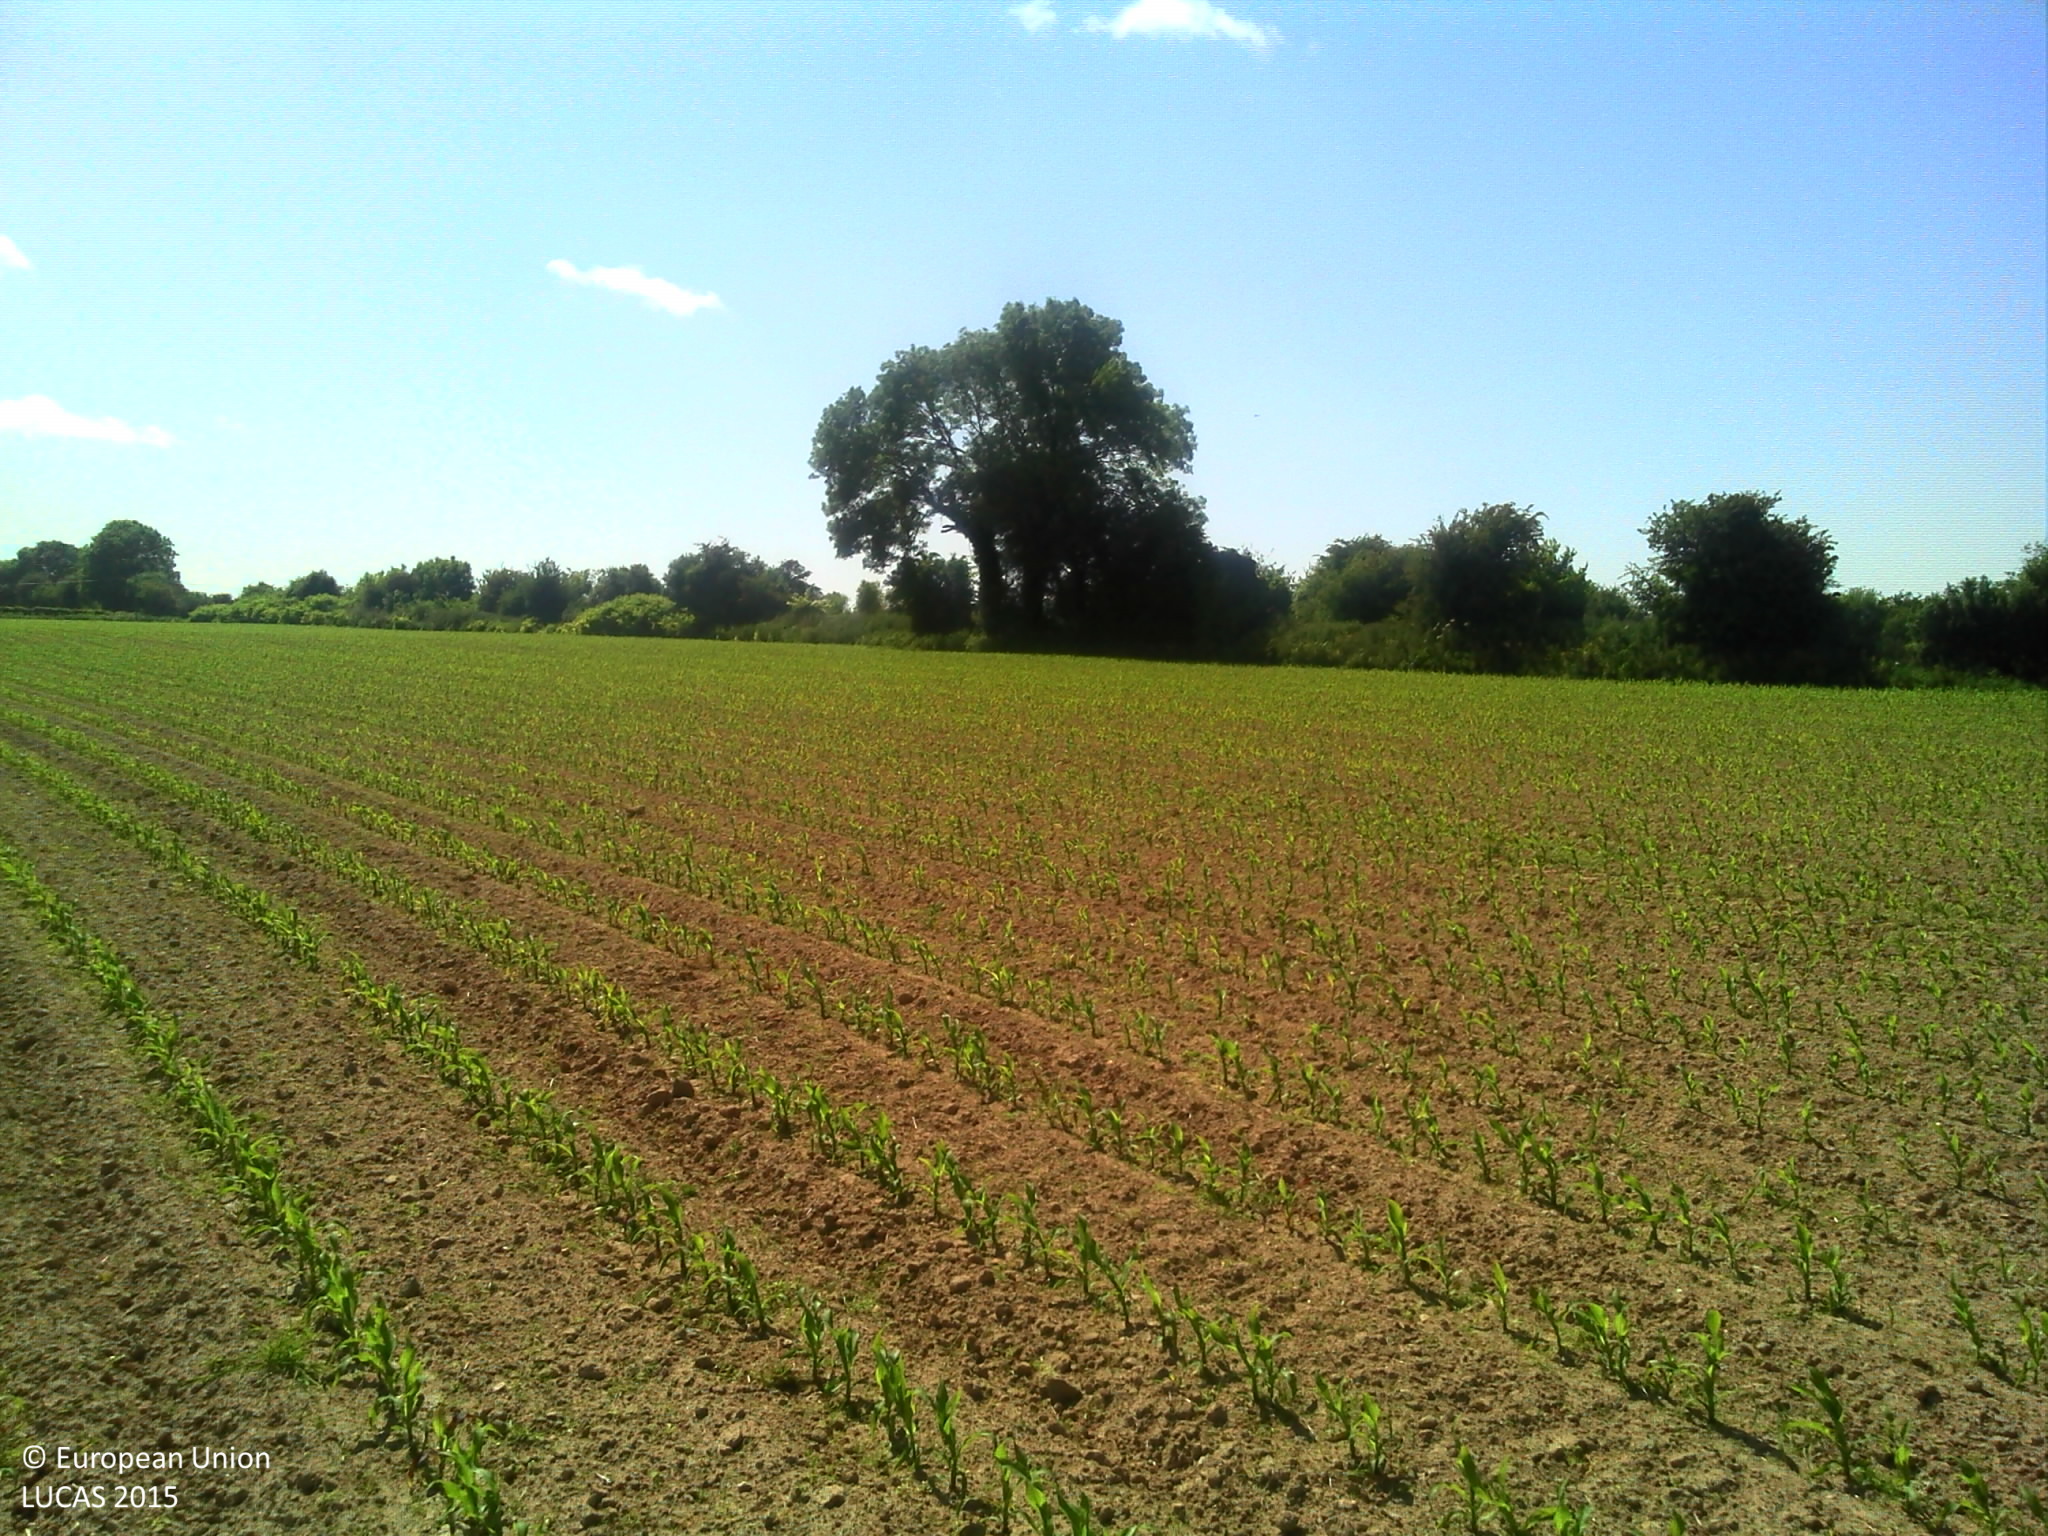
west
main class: Cropland
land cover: Maize
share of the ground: 10 - 25 %
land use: Agriculture (excluding fallow land and kitchen gardens)
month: June
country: FR
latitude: 49.6597
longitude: -1.4502
